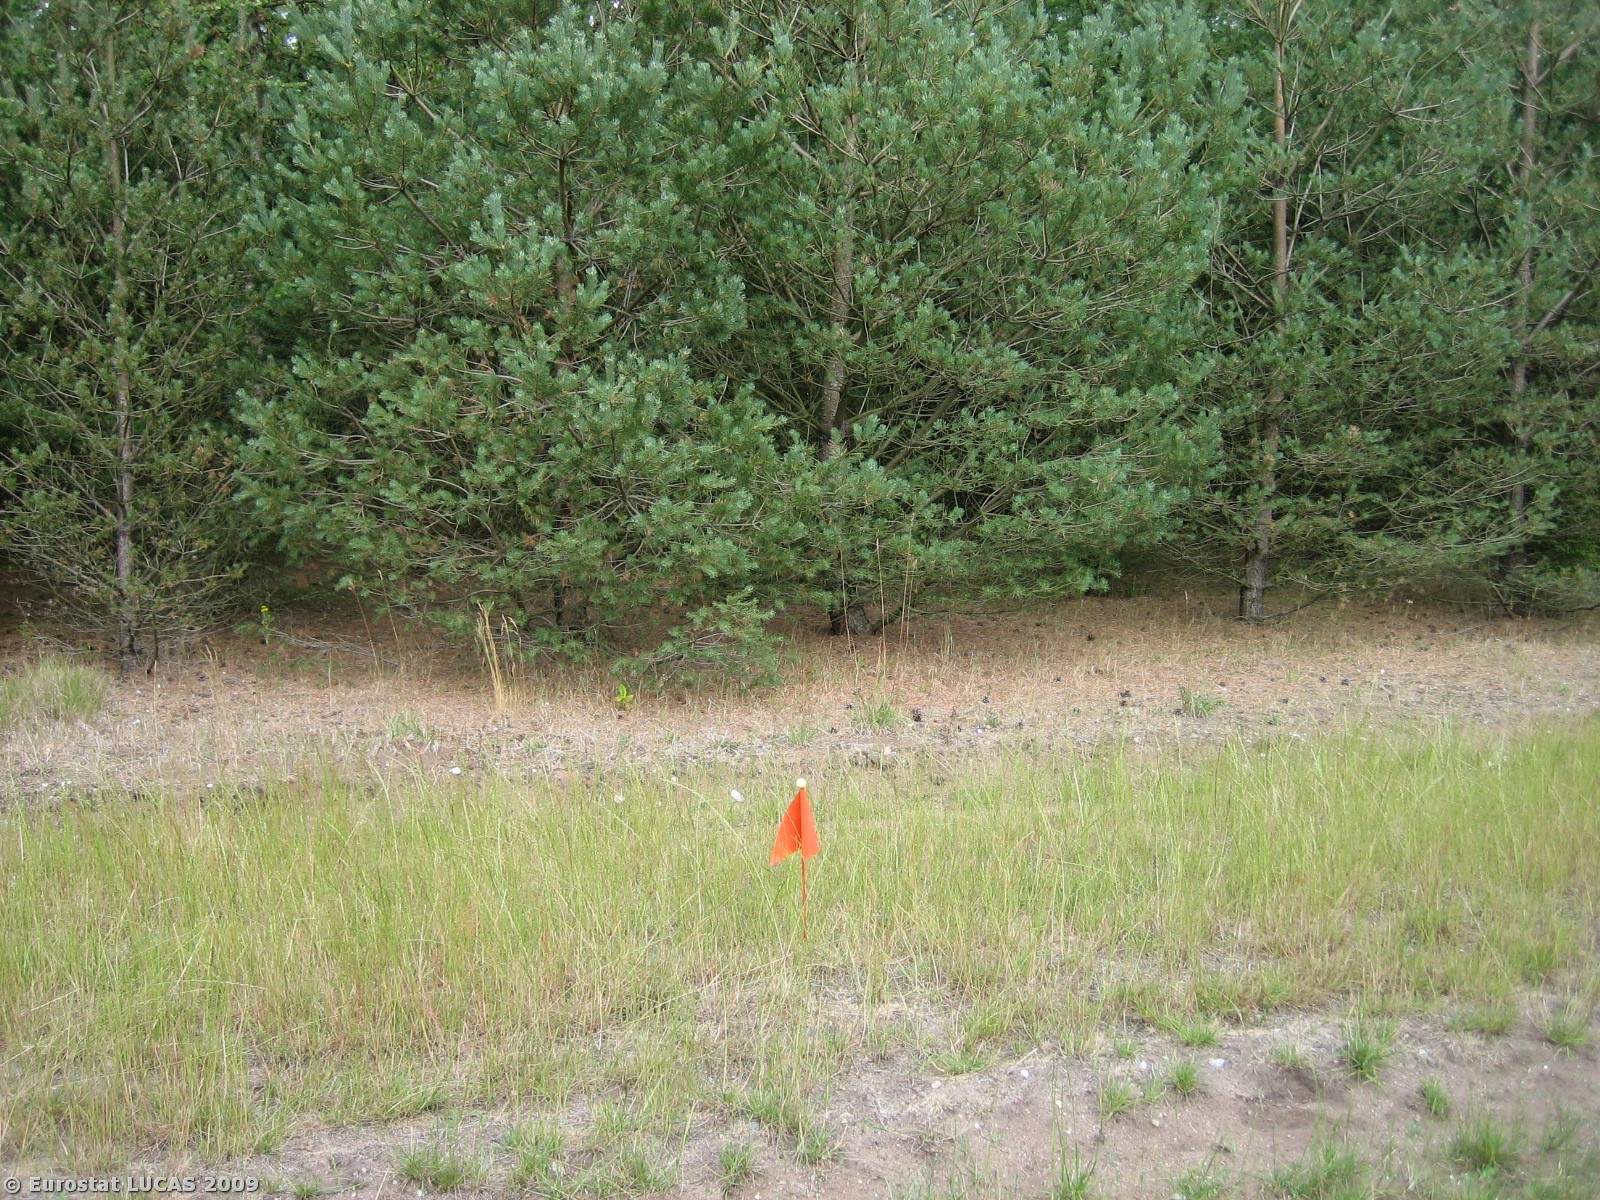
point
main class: Grassland
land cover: Grassland without tree/shrub cover
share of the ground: 50 - 75 %
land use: Forestry
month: July
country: DK
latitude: 55.8044
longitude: 8.7728
